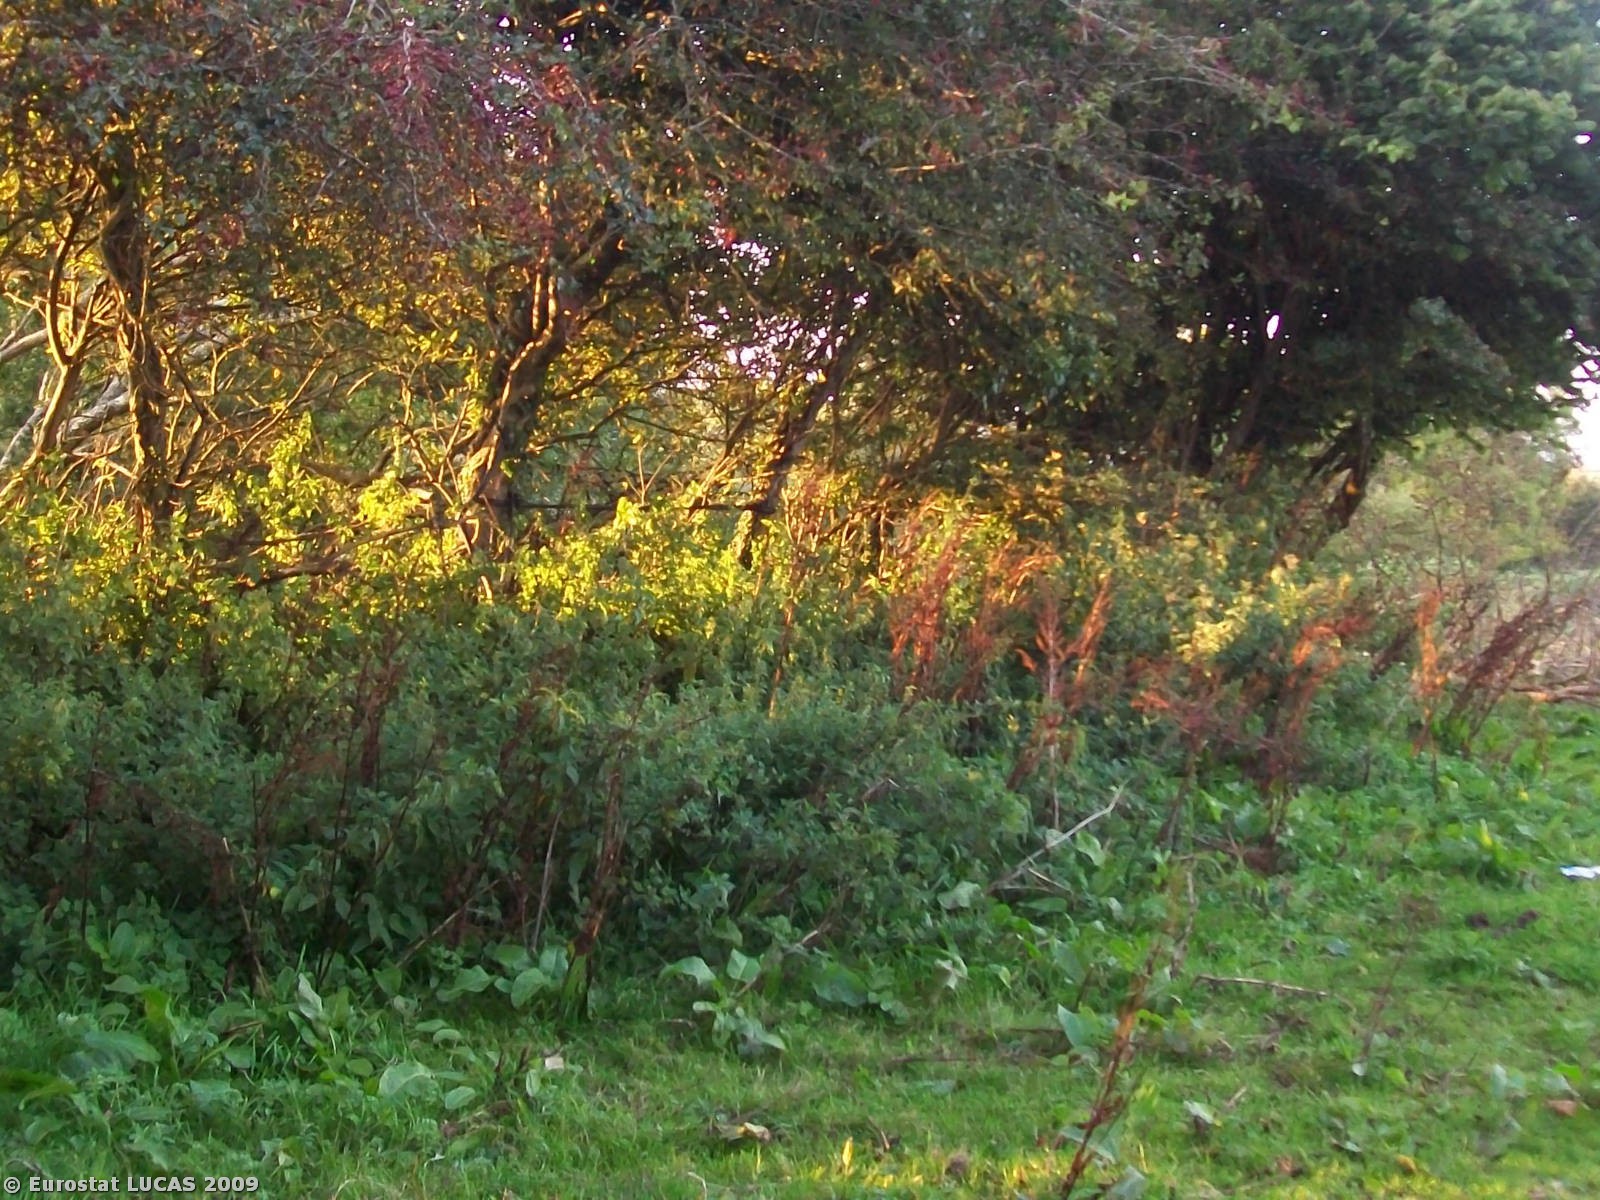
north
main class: Grassland
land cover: Grassland without tree/shrub cover
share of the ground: > 75 %
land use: Agriculture (excluding fallow land and kitchen gardens)
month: September
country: GB
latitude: 51.6844
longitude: -4.9117
